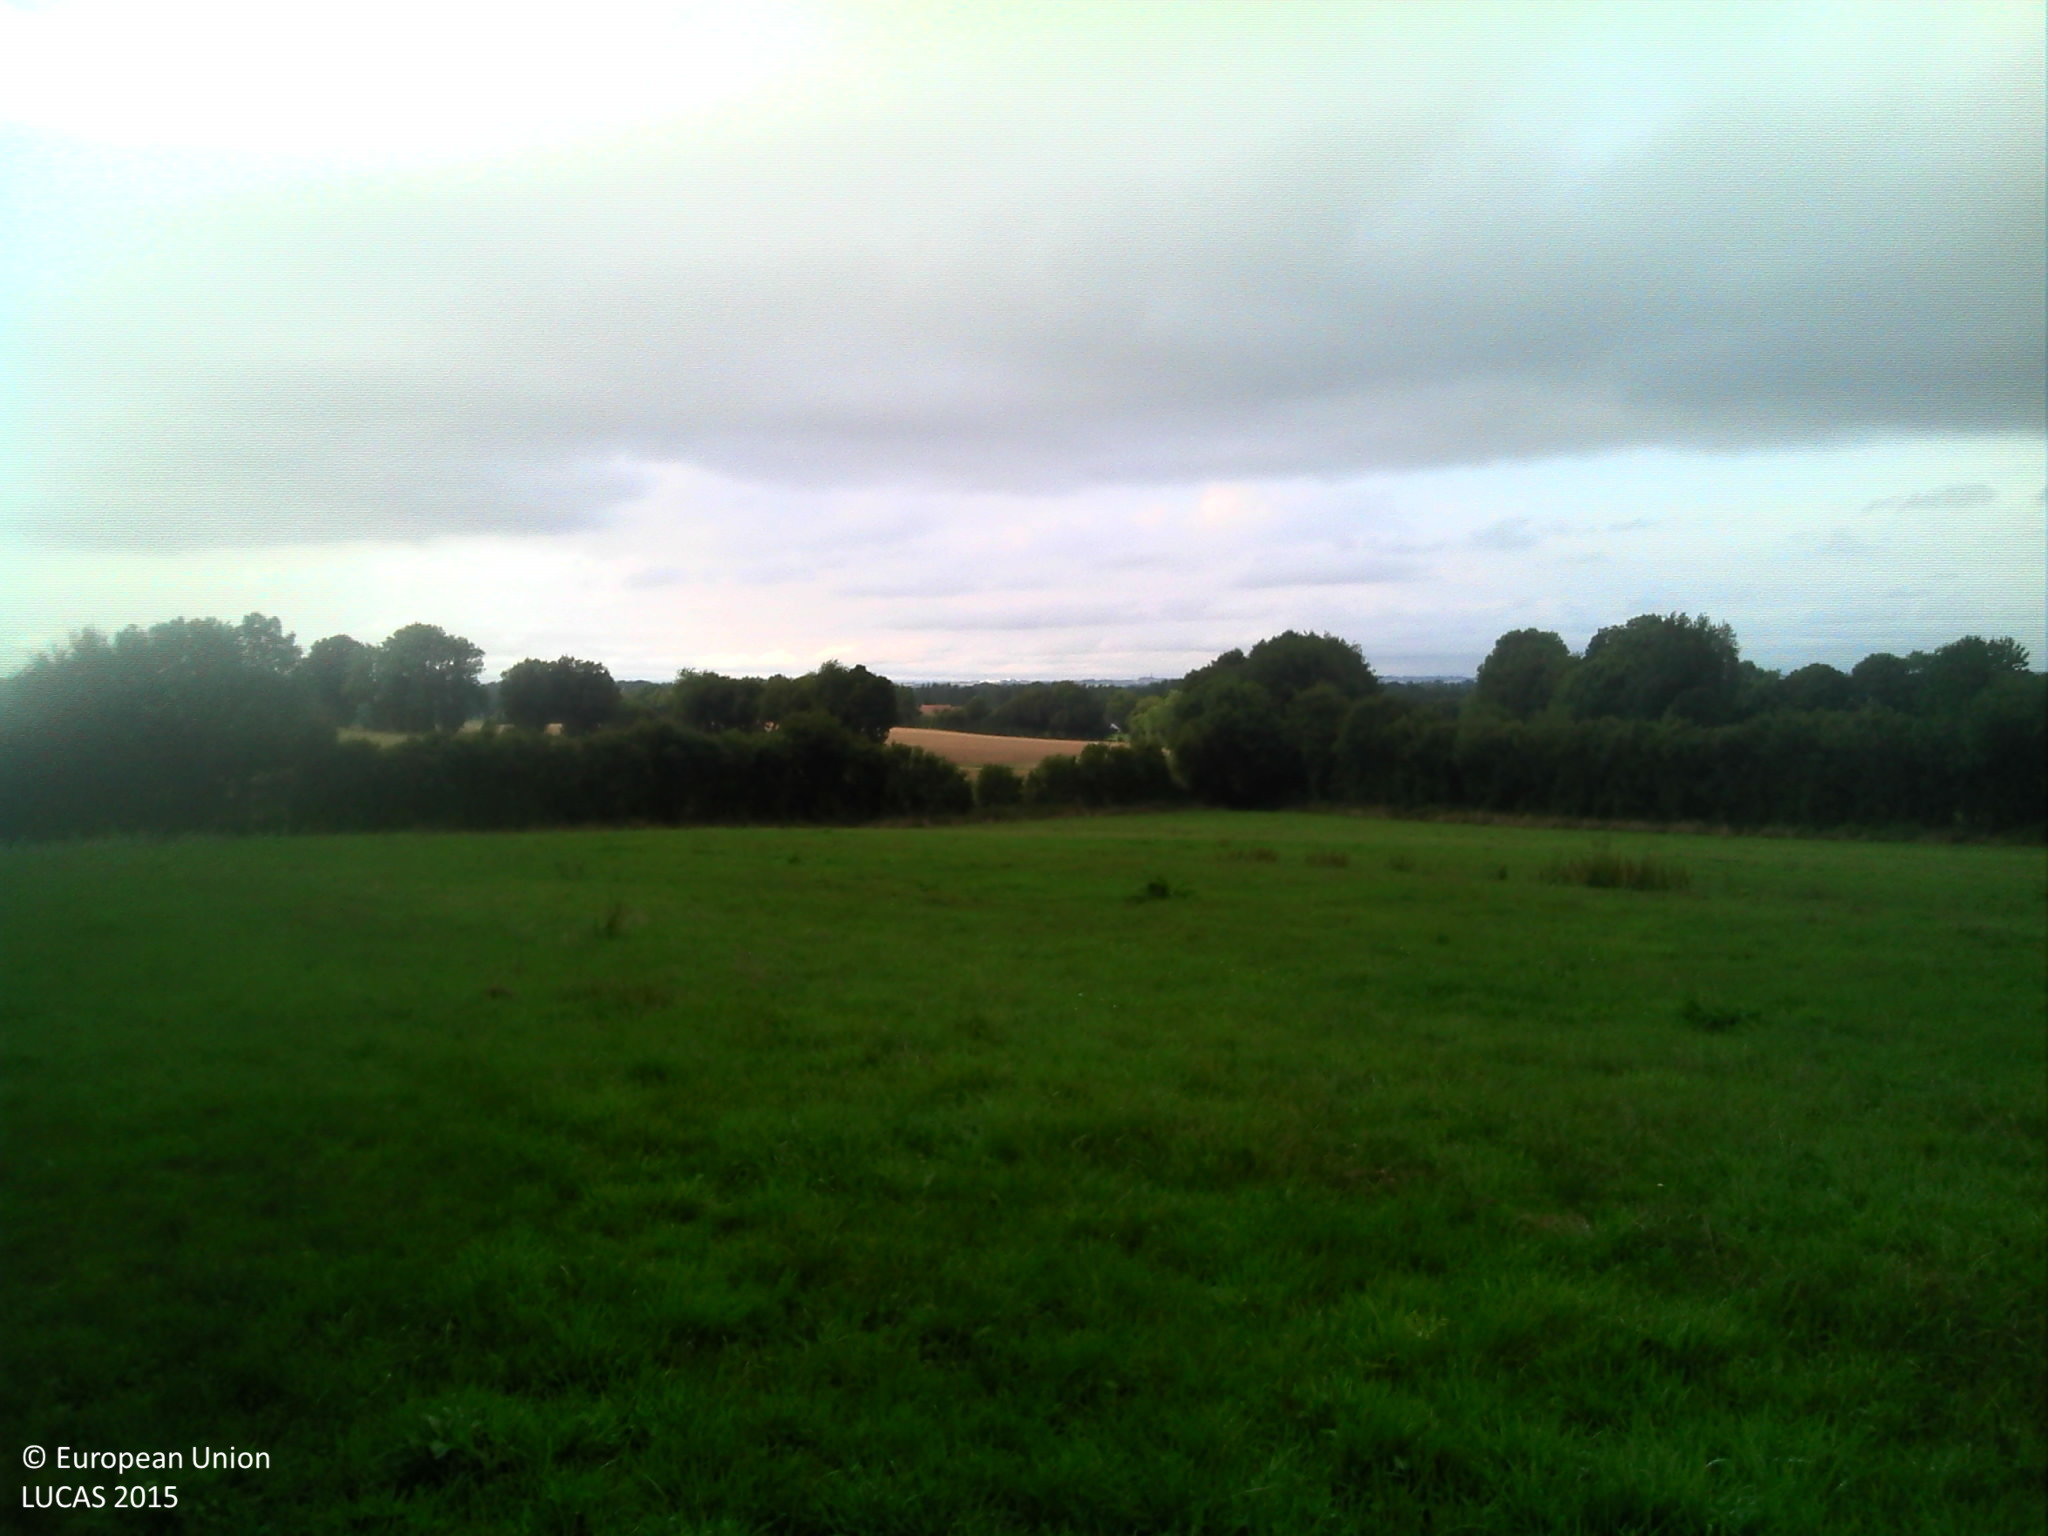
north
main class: Grassland
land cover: Grassland without tree/shrub cover
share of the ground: > 75 %
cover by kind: herbaceous plants 100 %
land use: Agriculture (excluding fallow land and kitchen gardens)
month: August
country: FR
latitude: 48.4153
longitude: 0.5586
